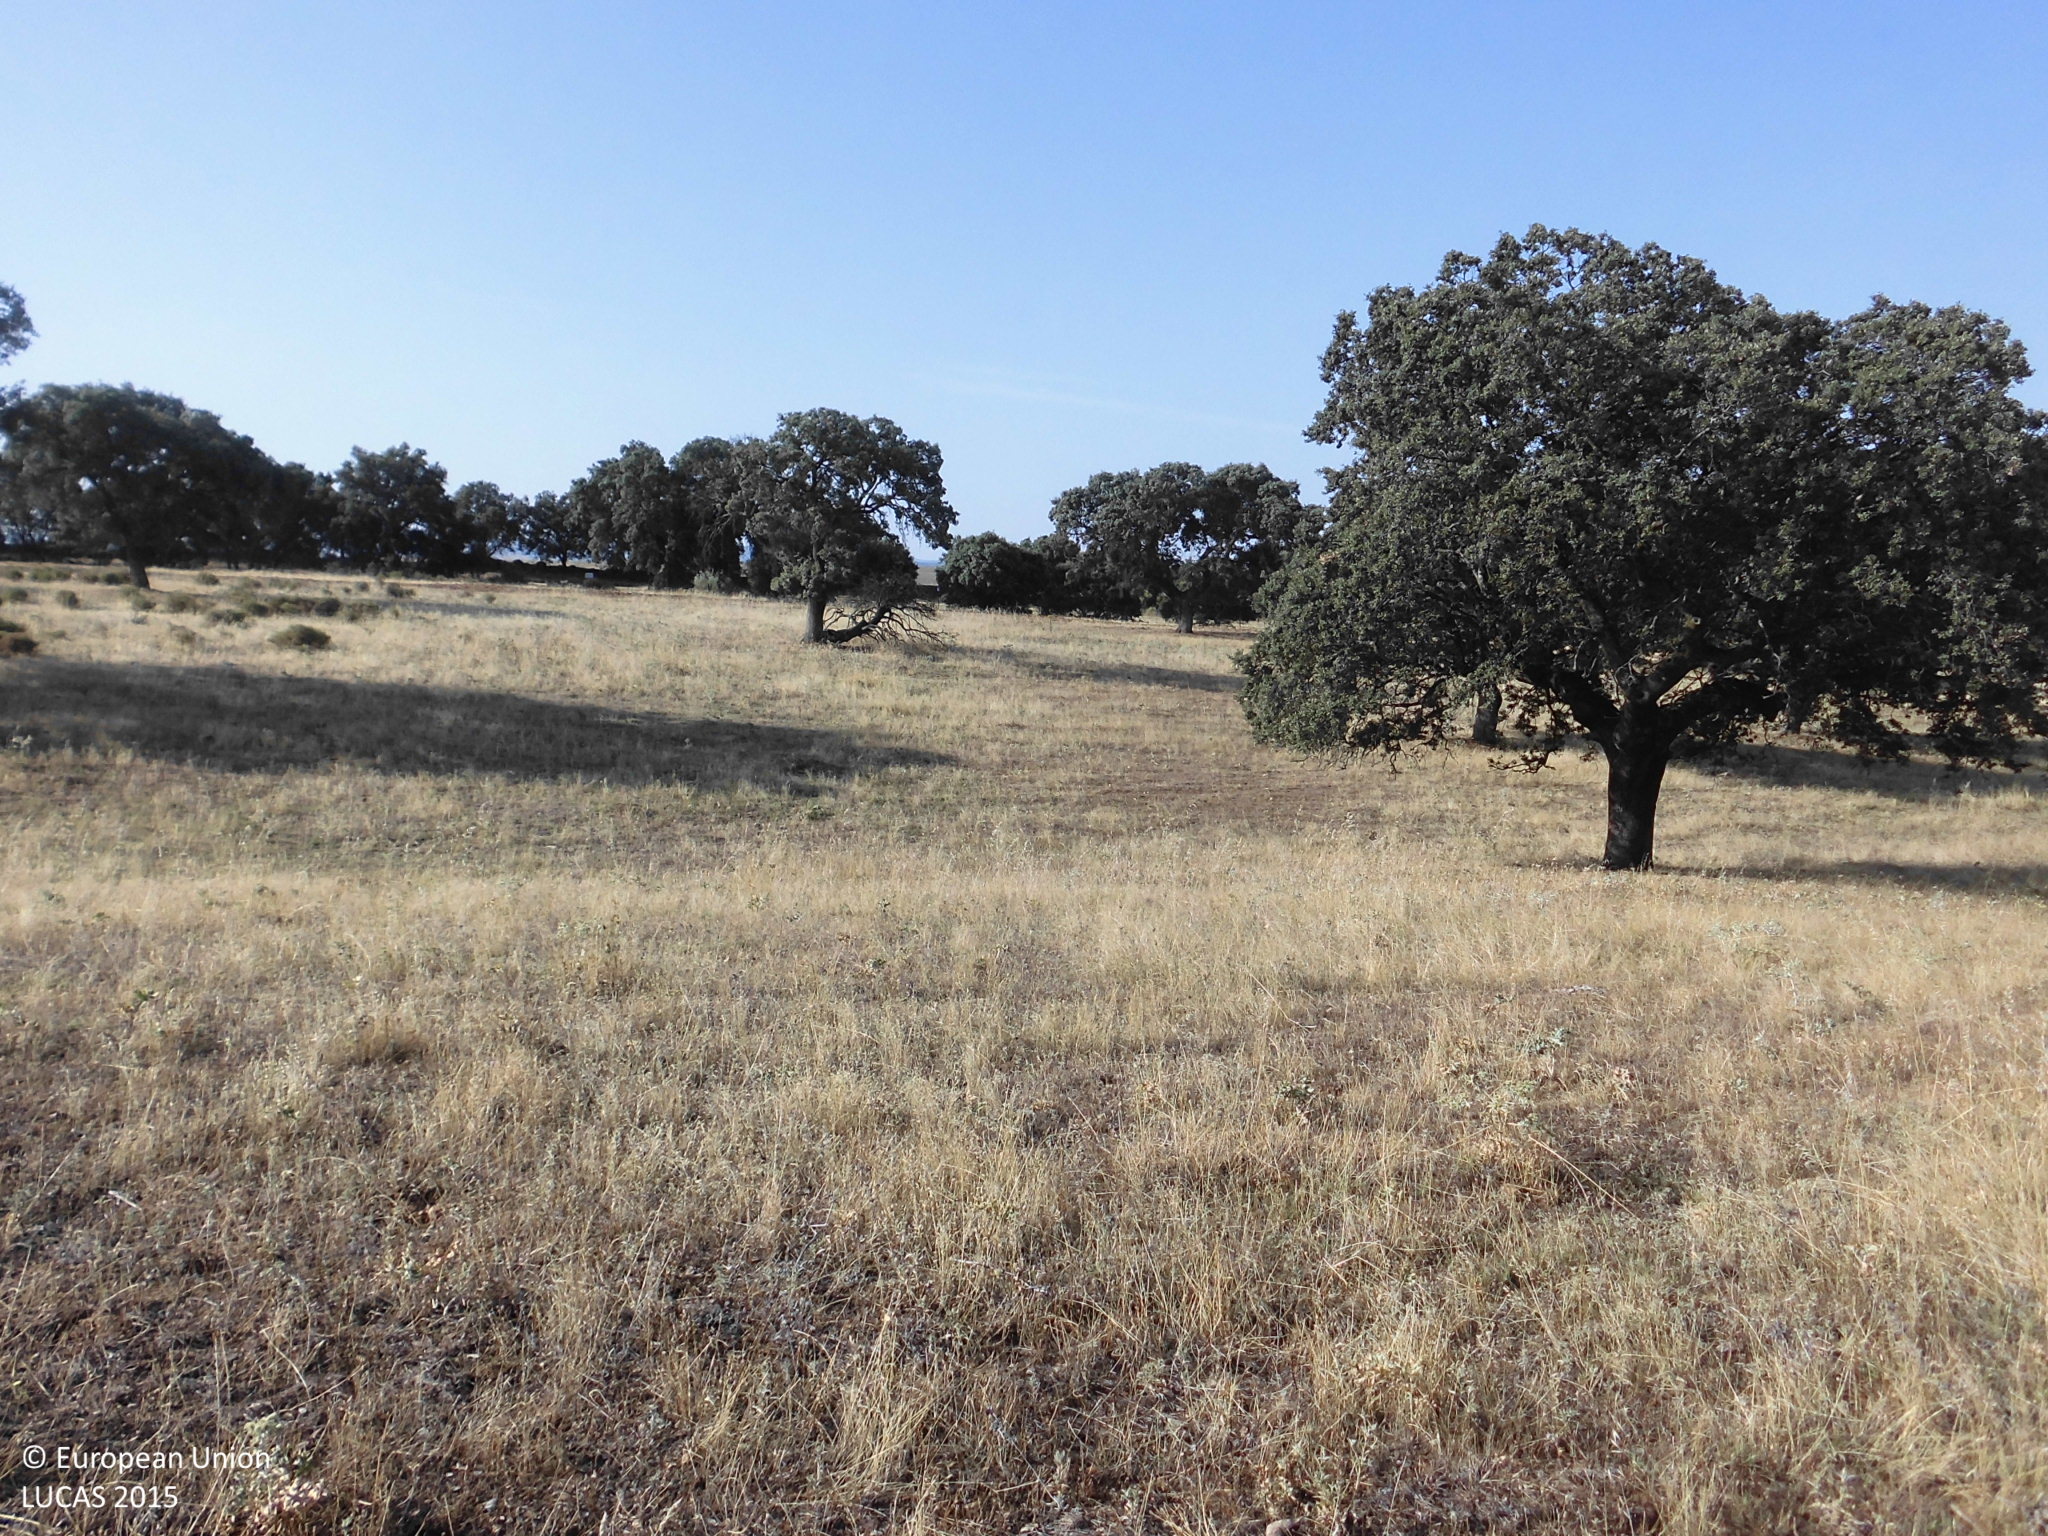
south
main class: Woodland
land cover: Broadleaved woodland
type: broadleaved evergreen forest
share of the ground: 25 - 50 %
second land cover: Grassland without tree/shrub cover
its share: > 75 %
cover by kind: herbaceous plants 70 %, broadleaved forest trees 30 %
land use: Forestry
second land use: Agriculture (excluding fallow land and kitchen gardens)
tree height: > 5 m
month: July
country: ES
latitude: 39.8583
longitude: -5.4752
